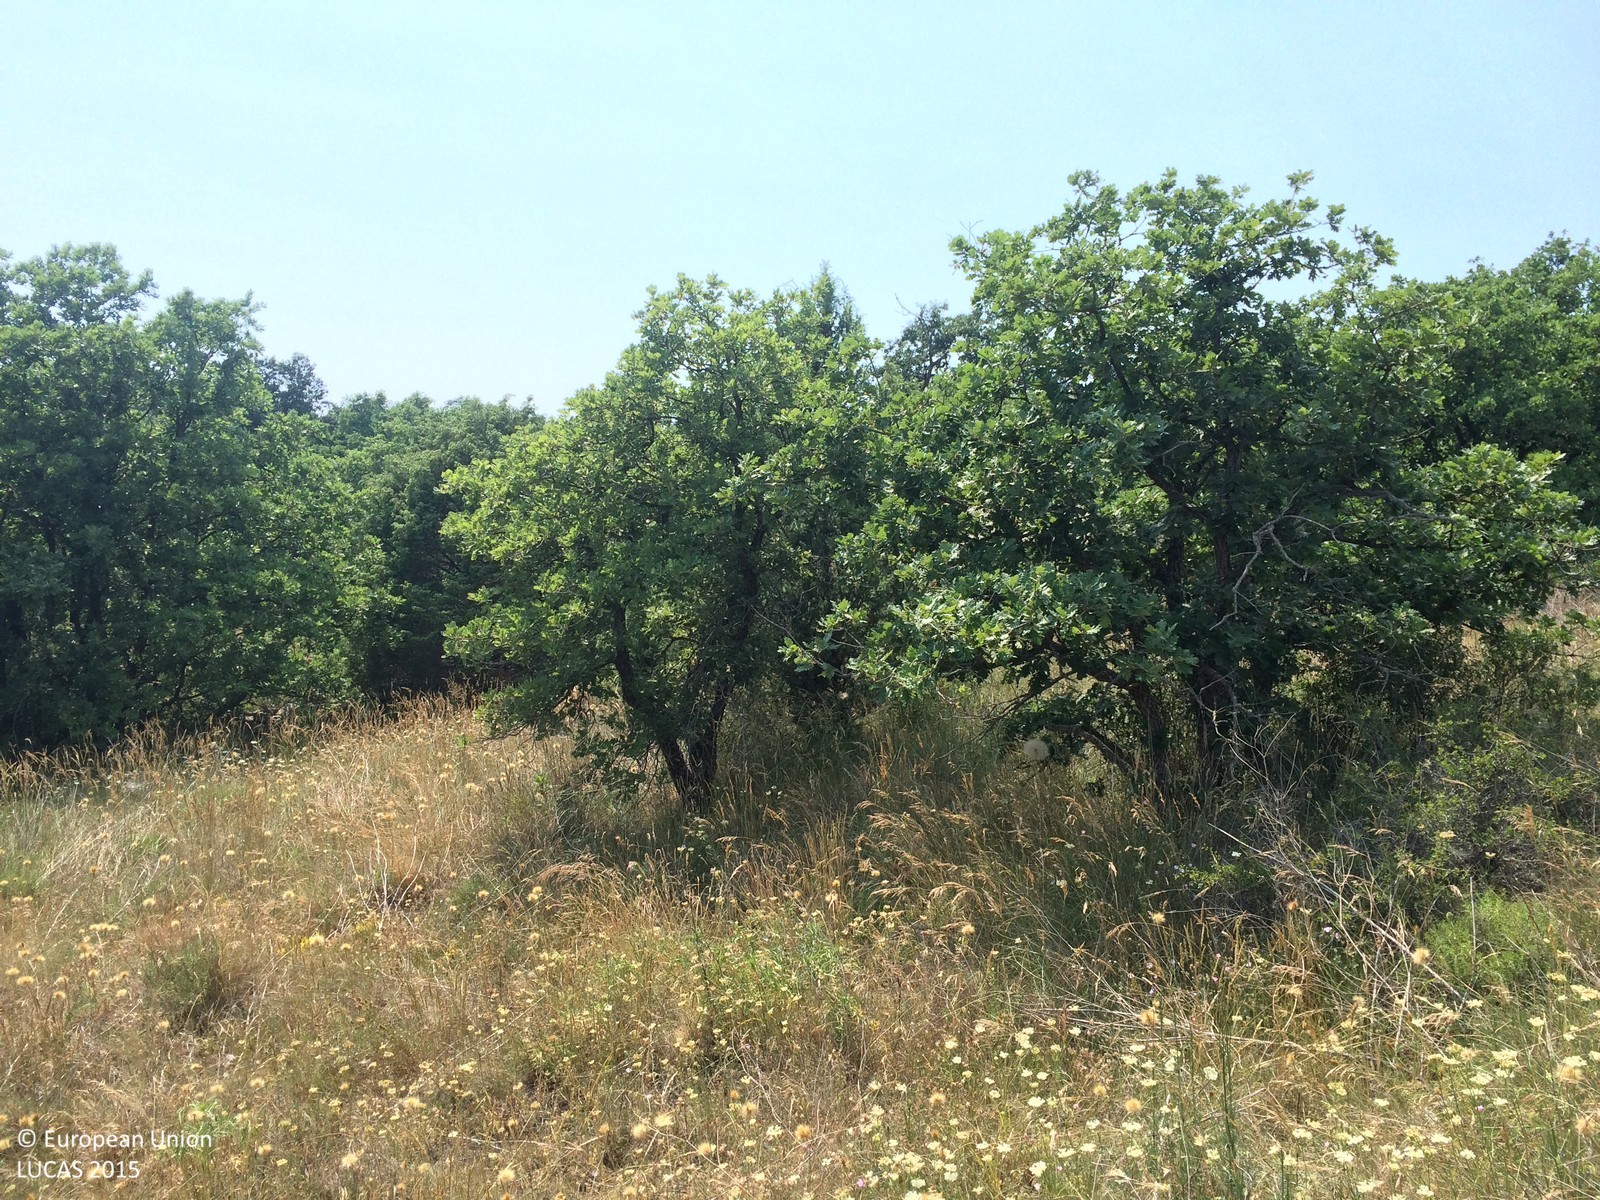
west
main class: Grassland
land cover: Grassland with sparse tree/shrub cover
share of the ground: > 75 %
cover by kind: herbaceous plants 90 %, broadleaved forest trees 5 %, shrubs 5 %
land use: Semi-natural and natural areas not in use
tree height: < 5 m
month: June
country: HR
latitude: 45.0925
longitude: 13.8191
